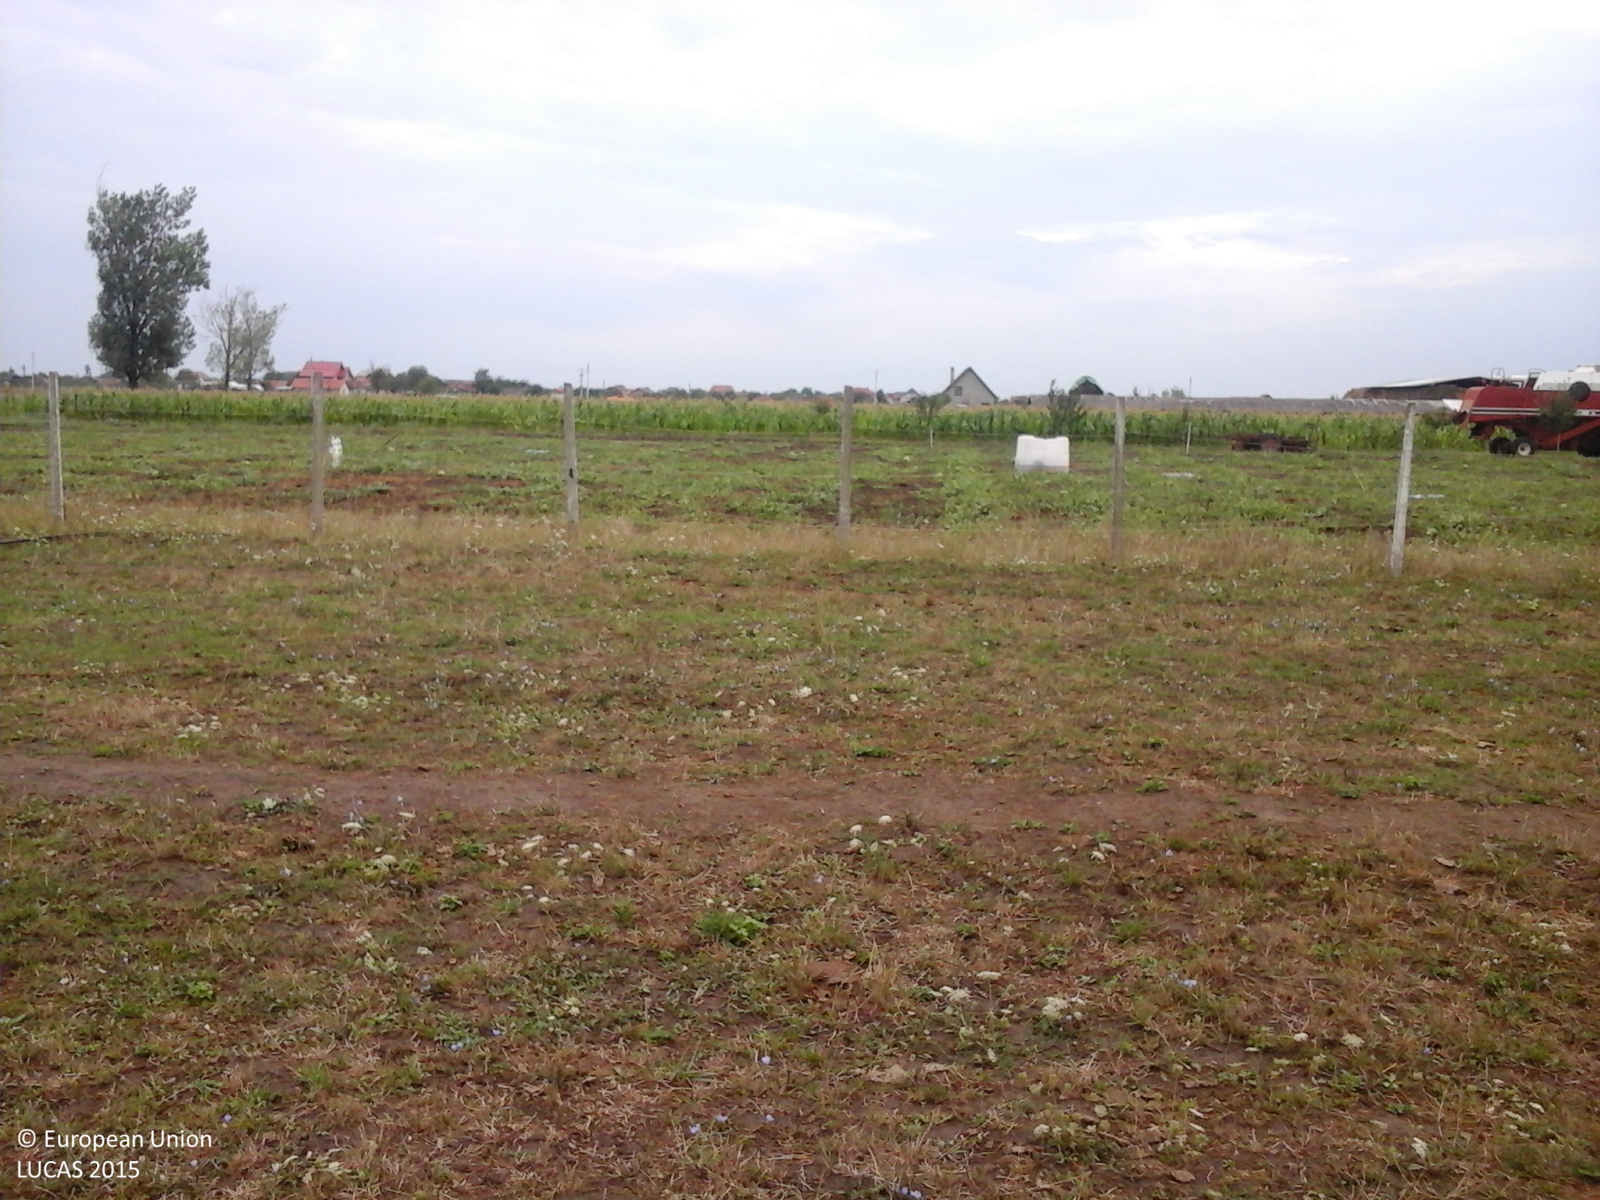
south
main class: Grassland
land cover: Grassland without tree/shrub cover
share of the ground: > 75 %
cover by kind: herbaceous plants 100 %
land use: Agriculture (excluding fallow land and kitchen gardens)
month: August
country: RO
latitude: 45.8072
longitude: 21.4472
